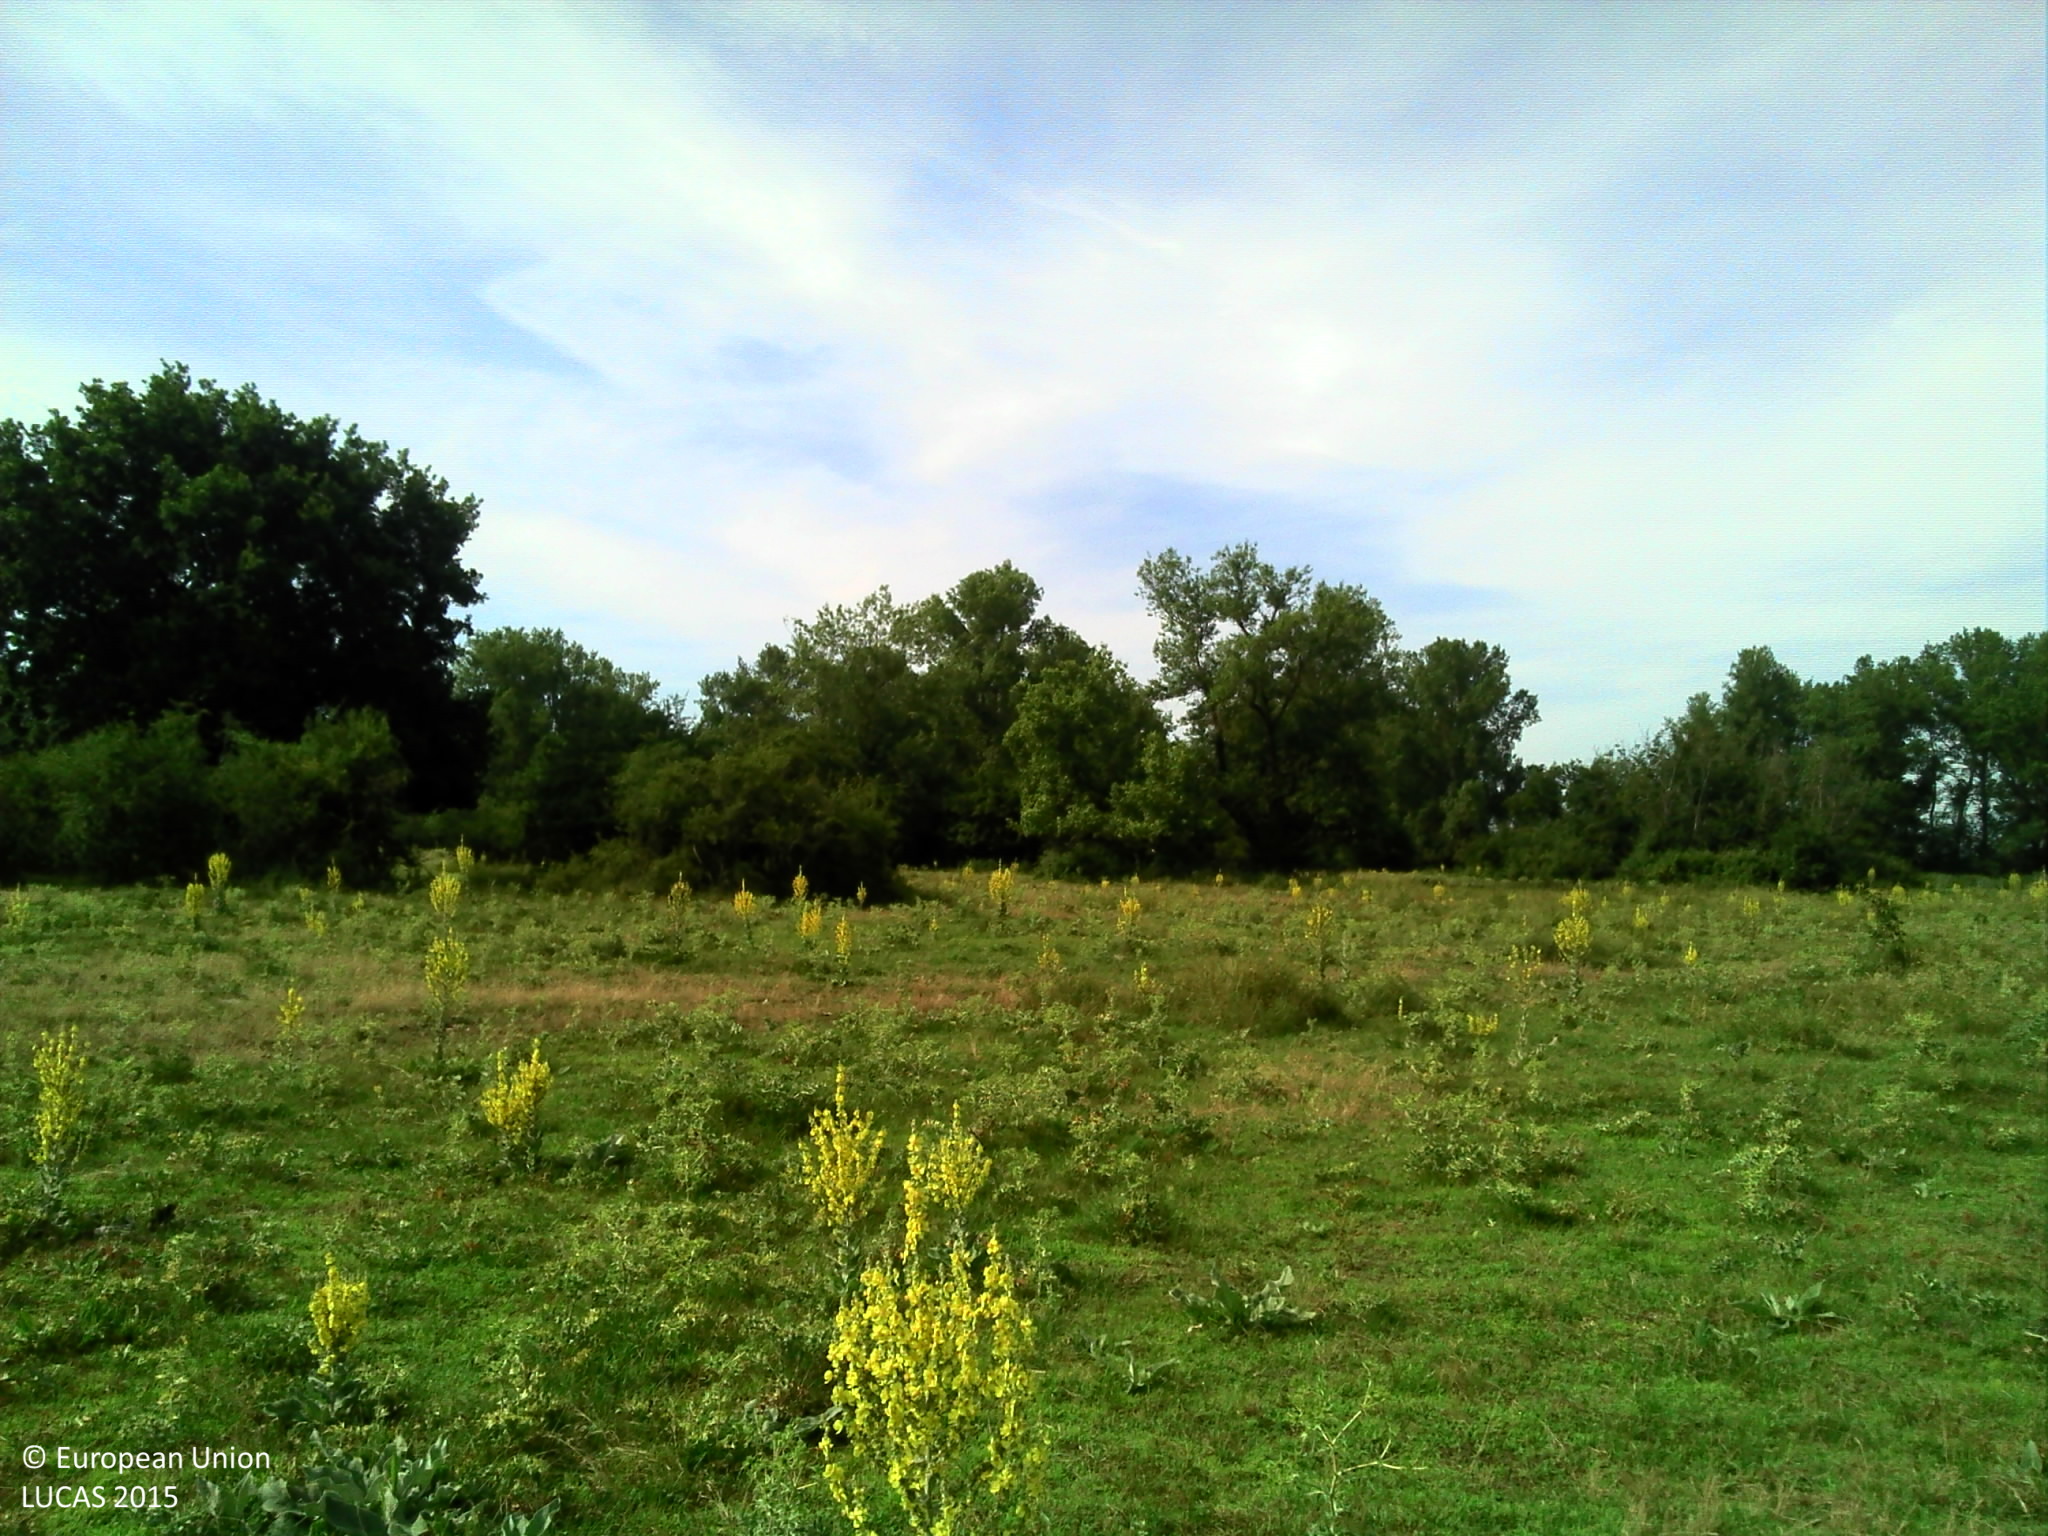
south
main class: Grassland
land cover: Grassland without tree/shrub cover
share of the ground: > 75 %
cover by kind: herbaceous plants 95 %, shrubs 5 %
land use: Agriculture (excluding fallow land and kitchen gardens)
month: June
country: FR
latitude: 46.3599
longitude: 3.3313
